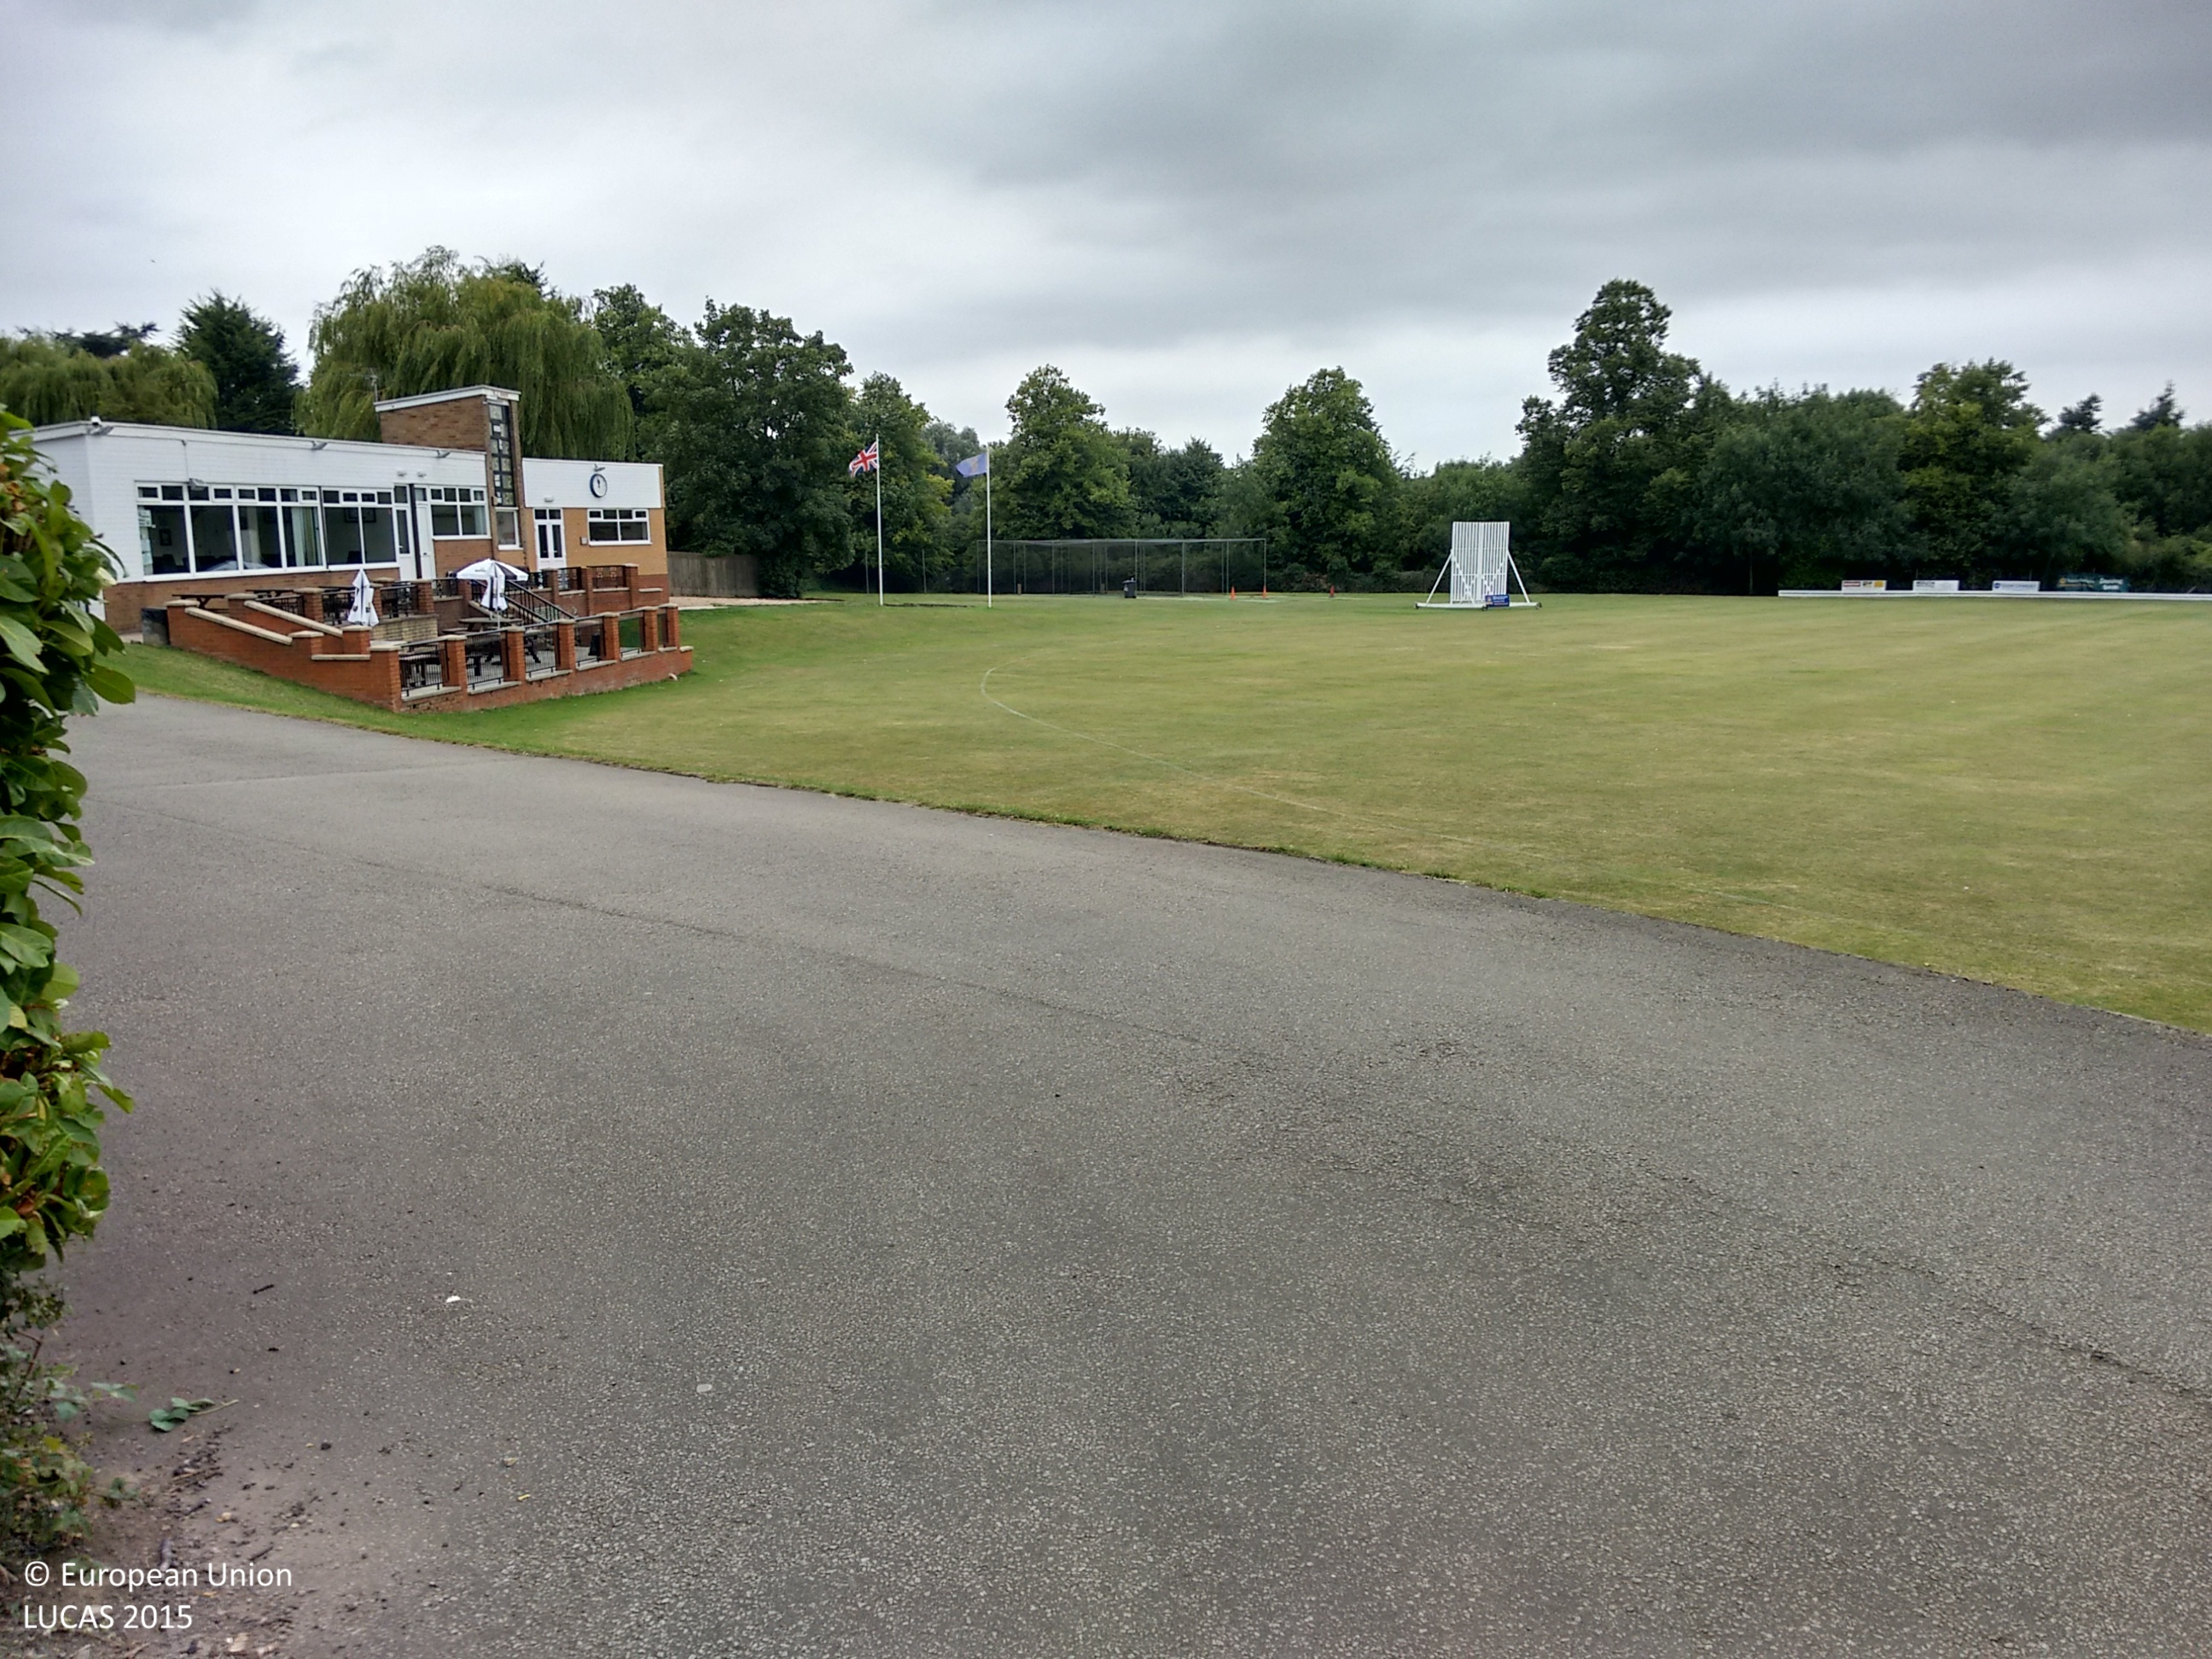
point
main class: Grassland
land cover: Grassland without tree/shrub cover
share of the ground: > 75 %
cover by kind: herbaceous plants 100 %
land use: Sport
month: August
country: GB
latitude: 52.3093
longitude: -0.7037
